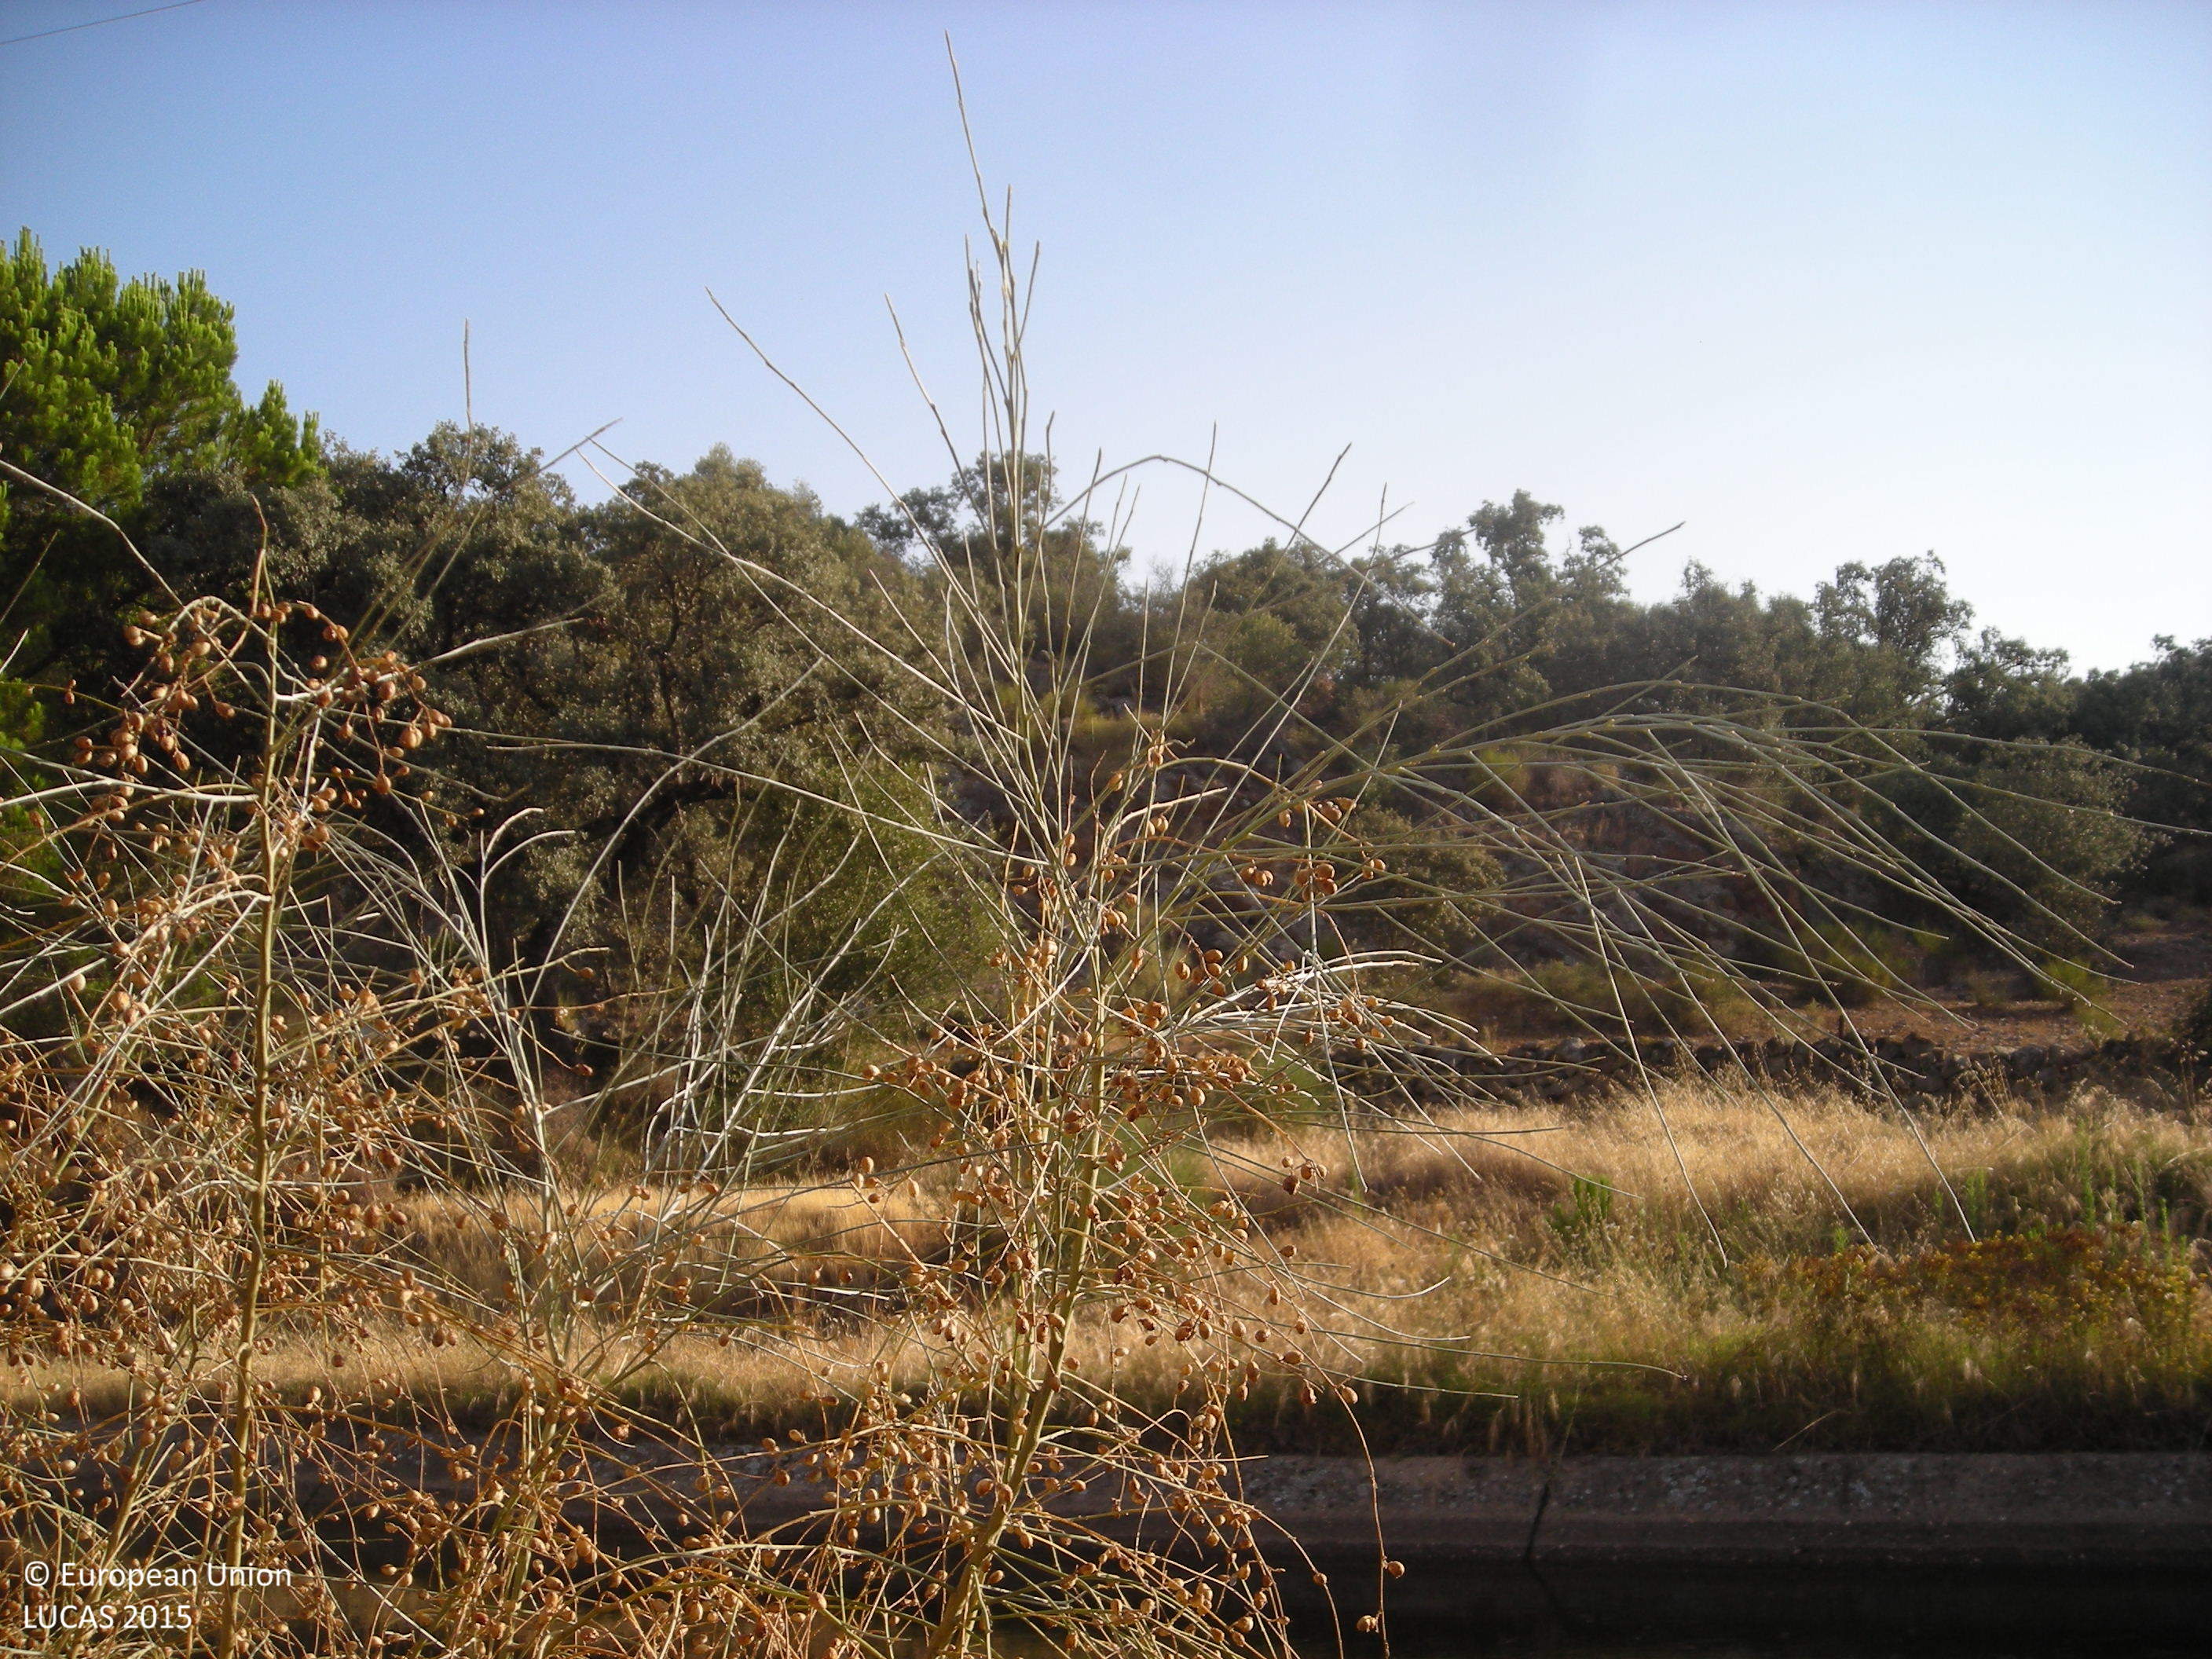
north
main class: Woodland
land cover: Broadleaved woodland
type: broadleaved evergreen forest
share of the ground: 50 - 75 %
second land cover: Grassland without tree/shrub cover
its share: 50 - 75 %
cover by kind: broadleaved forest trees 60 %, herbaceous plants 40 %
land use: Forestry
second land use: Agriculture (excluding fallow land and kitchen gardens)
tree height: > 5 m
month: July
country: ES
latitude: 39.1491
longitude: -5.9882
